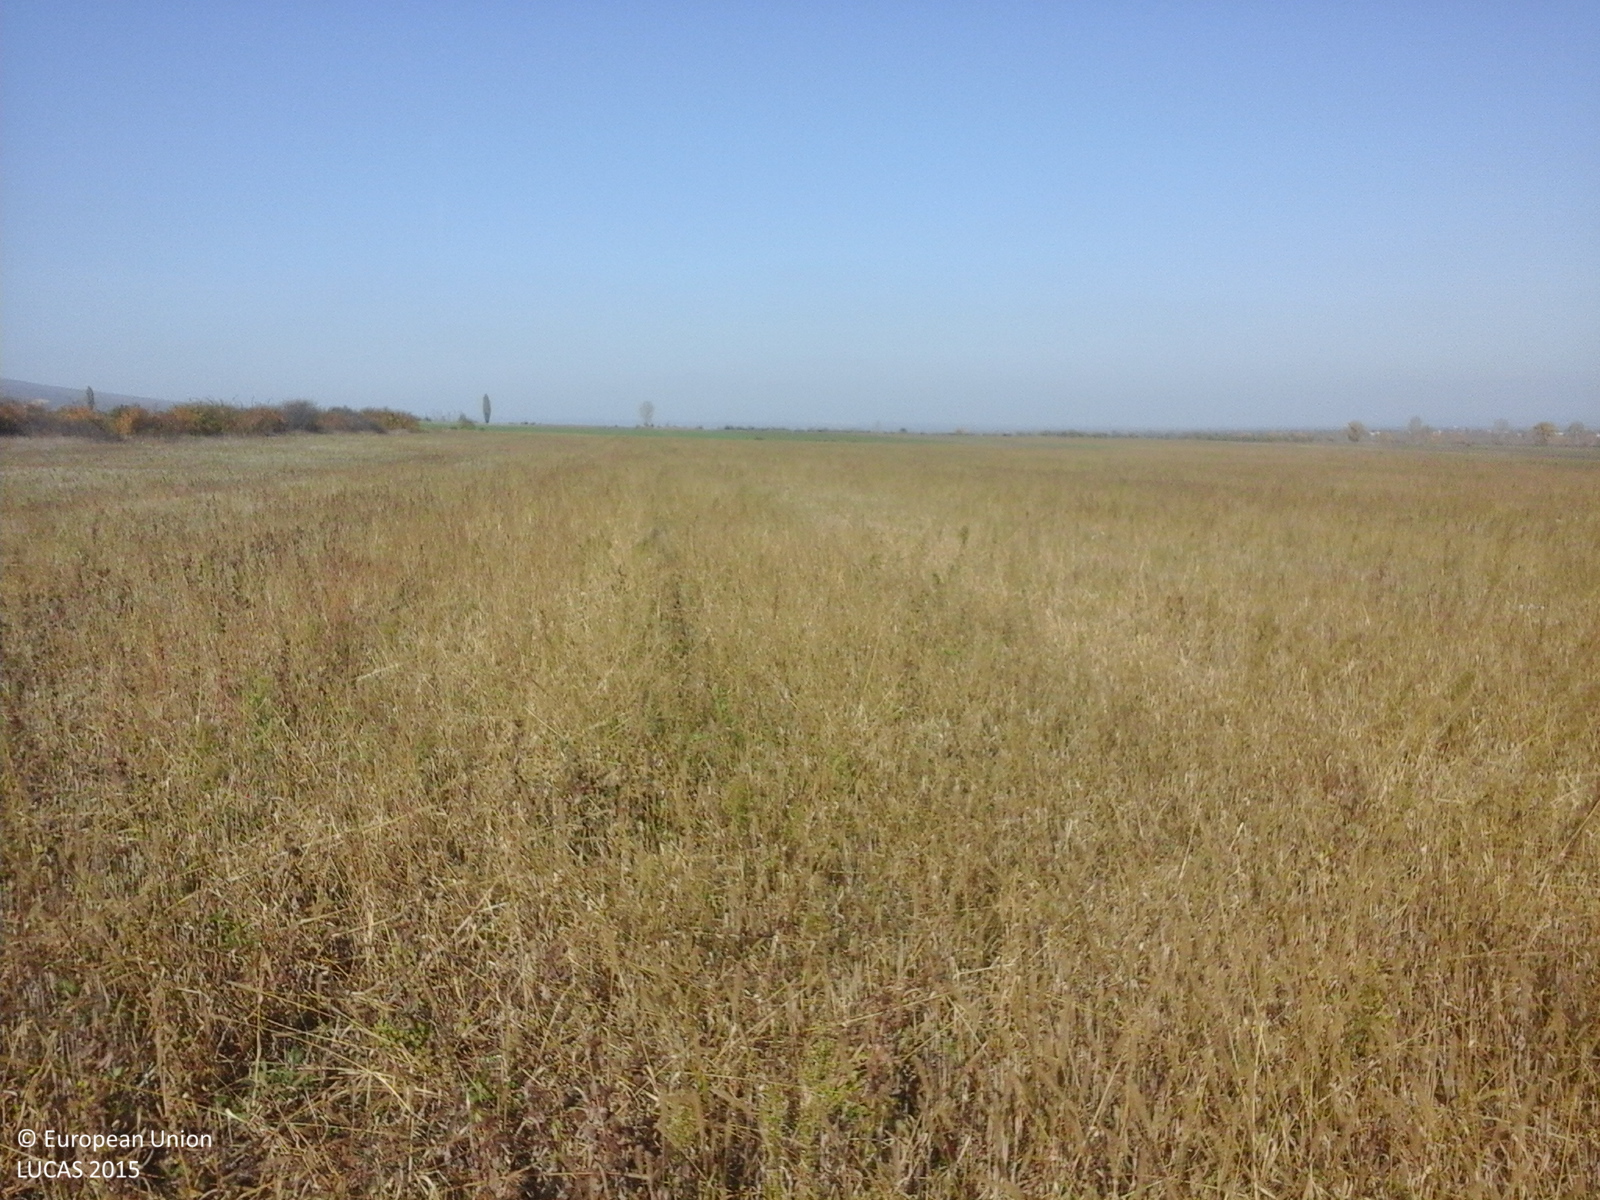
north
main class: Grassland
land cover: Spontaneously vegetated surfaces
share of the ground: > 75 %
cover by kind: herbaceous plants 100 %
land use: Fallow land
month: October
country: RO
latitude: 45.6996
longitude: 27.0834
